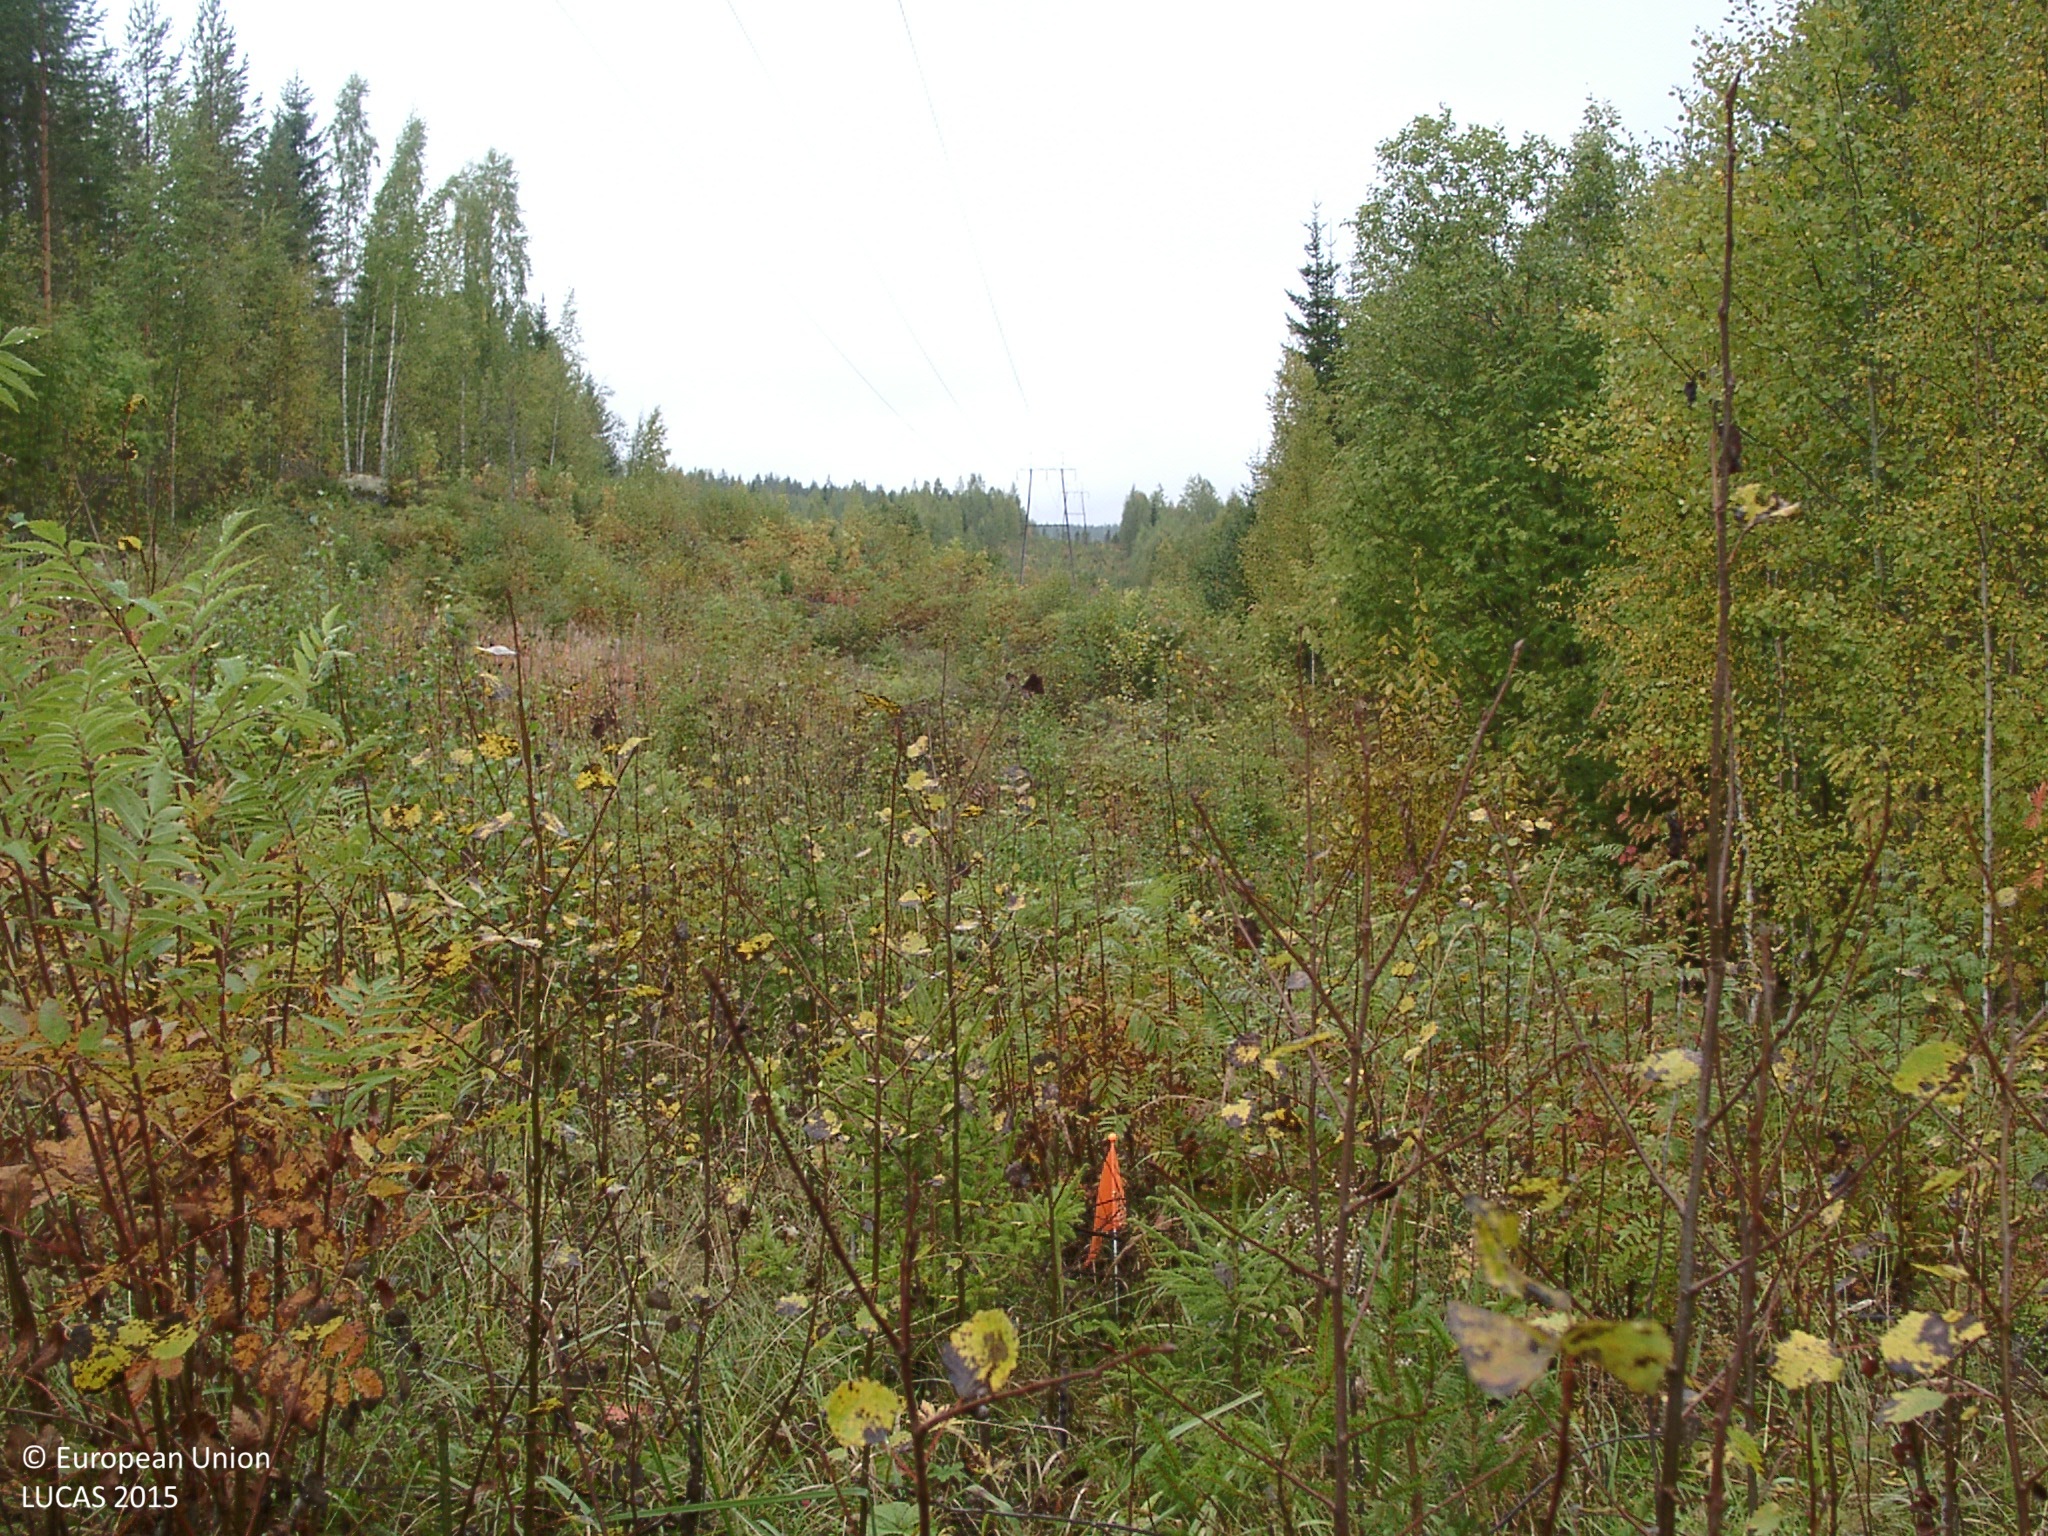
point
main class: Woodland
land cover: Broadleaved woodland
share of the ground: 25 - 50 %
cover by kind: herbaceous plants 60 %, broadleaved forest trees 35 %, shrubs 5 %
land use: Electricity, gas and thermal power distribution
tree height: < 5 m
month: September
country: FI
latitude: 62.5861
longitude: 25.5907
